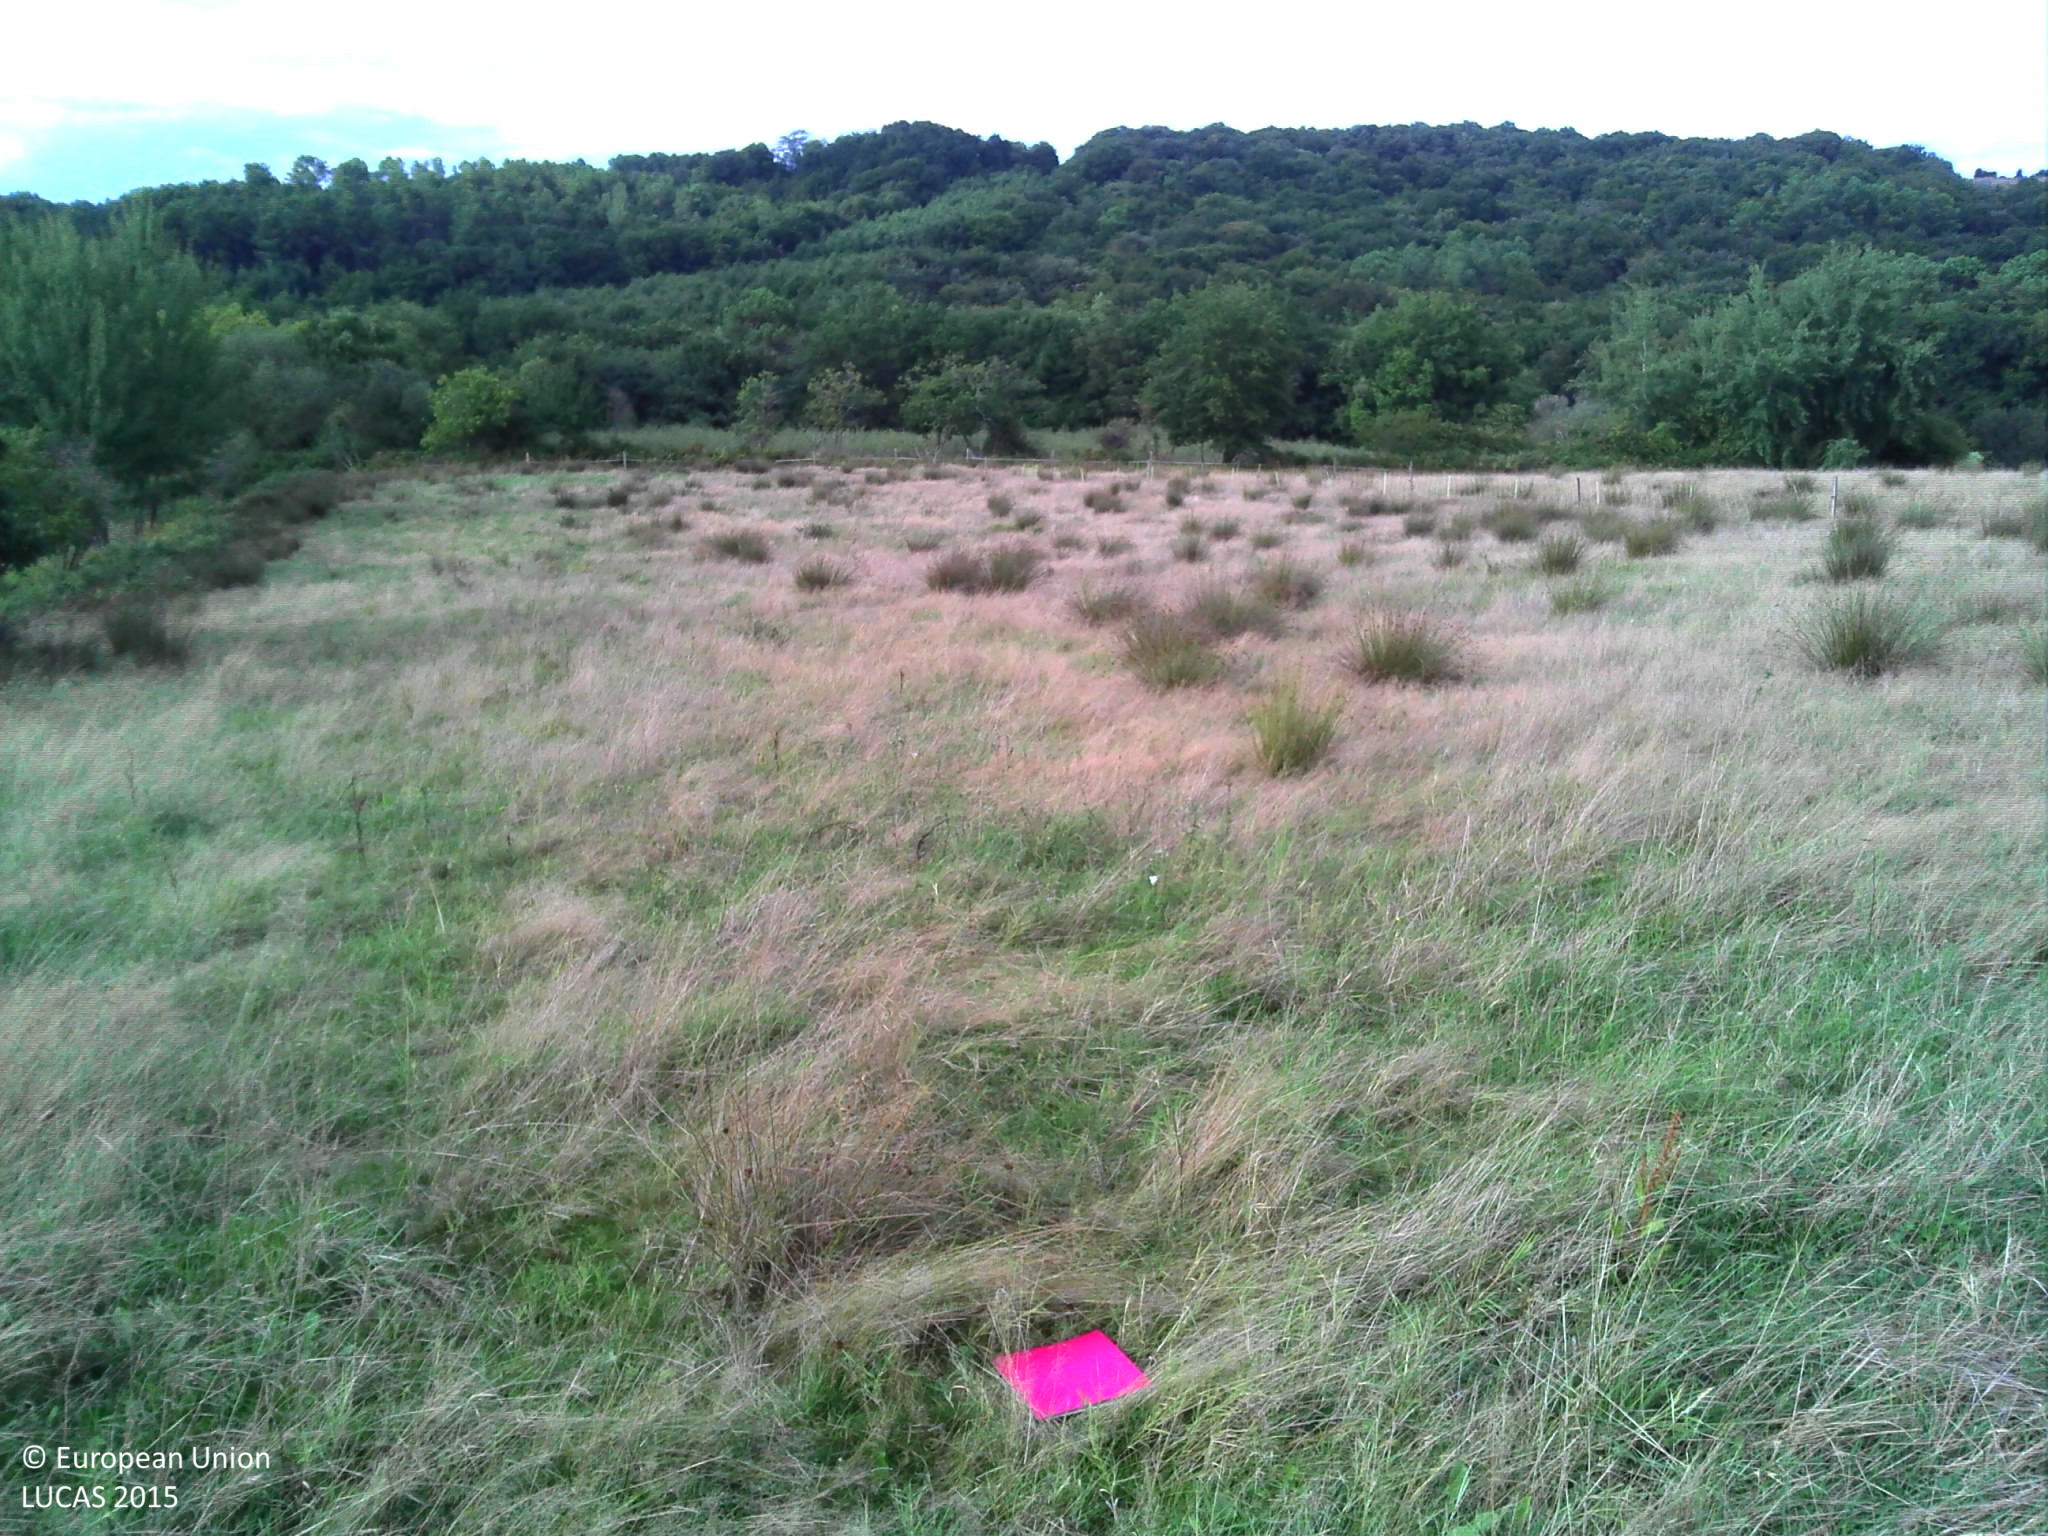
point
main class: Grassland
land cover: Grassland without tree/shrub cover
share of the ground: > 75 %
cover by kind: herbaceous plants 100 %
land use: Agriculture (excluding fallow land and kitchen gardens)
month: September
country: FR
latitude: 43.5216
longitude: -0.5382
